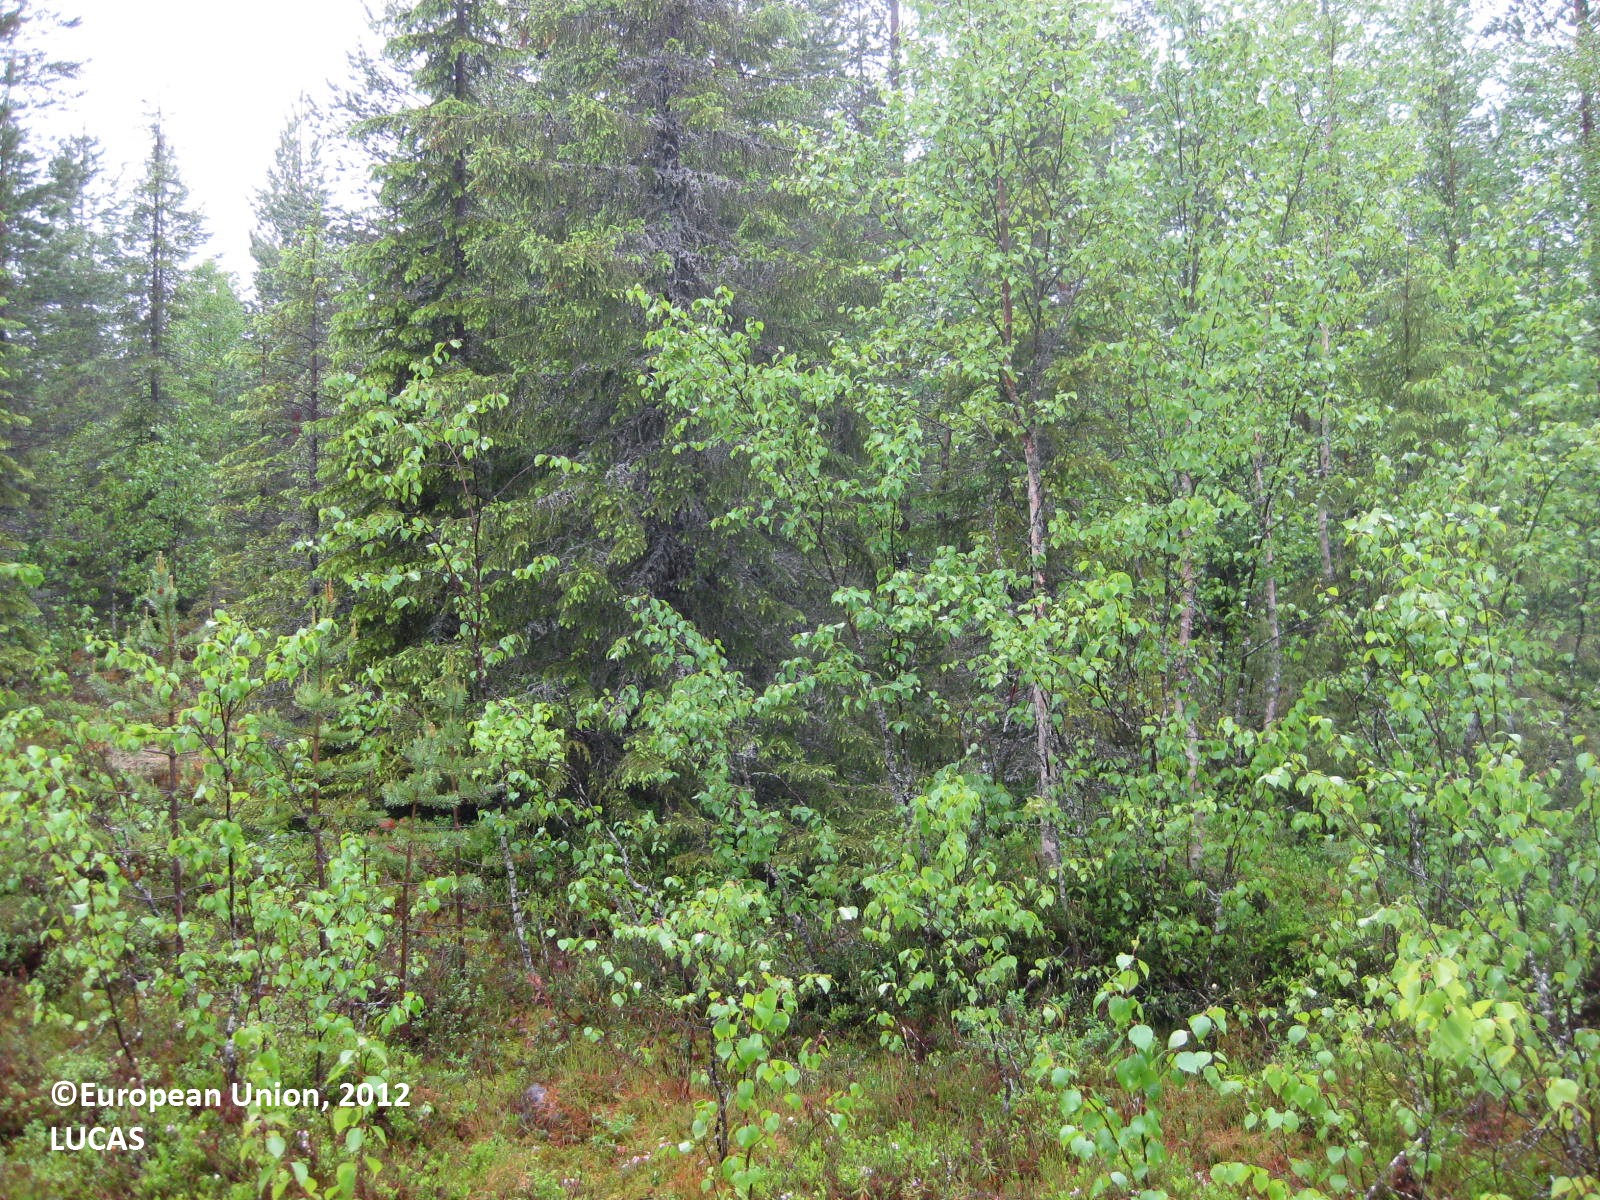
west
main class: Woodland
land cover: Other mixed woodland
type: boreal forest
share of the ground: 50 - 75 %
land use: Forestry
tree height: > 5 m
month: June
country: FI
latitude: 65.3449
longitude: 29.0240
